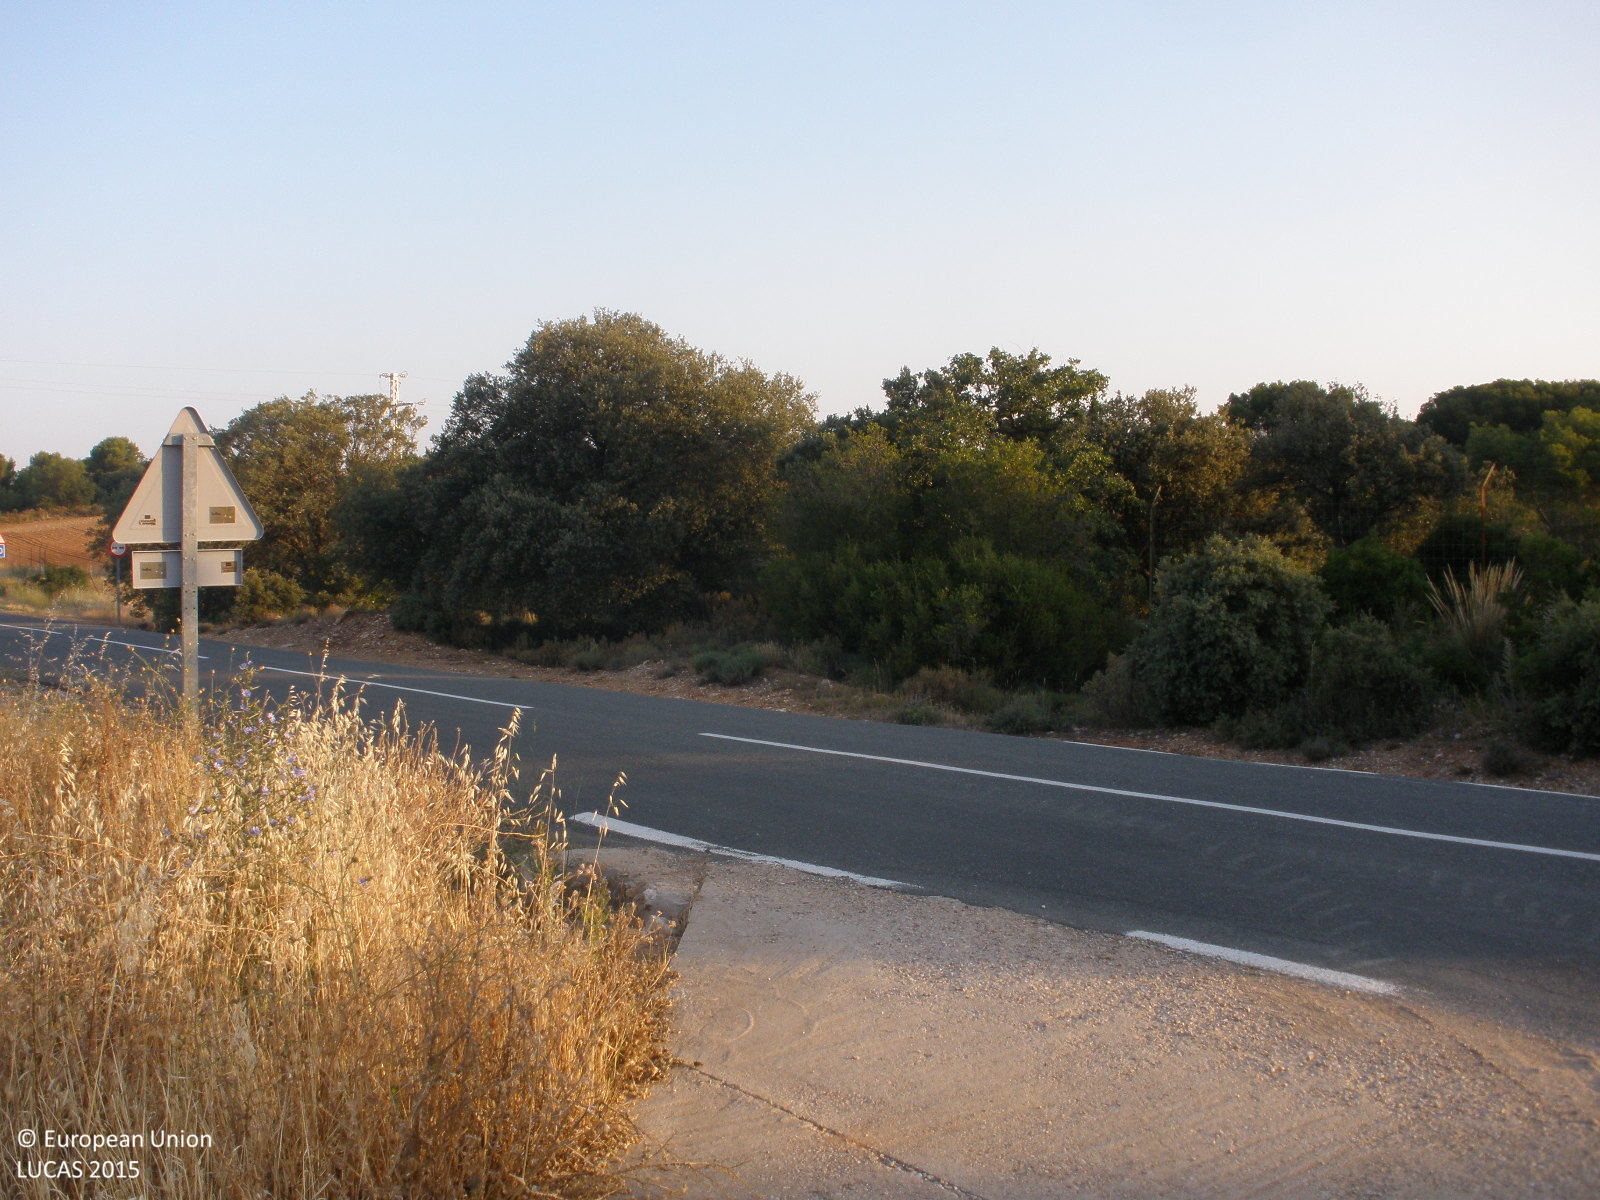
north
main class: Woodland
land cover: Pine dominated coniferous woodland
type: coniferous forest of the mediterranean region
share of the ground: 50 - 75 %
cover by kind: coniferous forest trees 50 %, herbaceous plants 30 %, unconsolidated bare surface 20 %
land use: Semi-natural and natural areas not in use
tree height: > 5 m
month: June
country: ES
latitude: 40.0843
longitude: -3.3395
